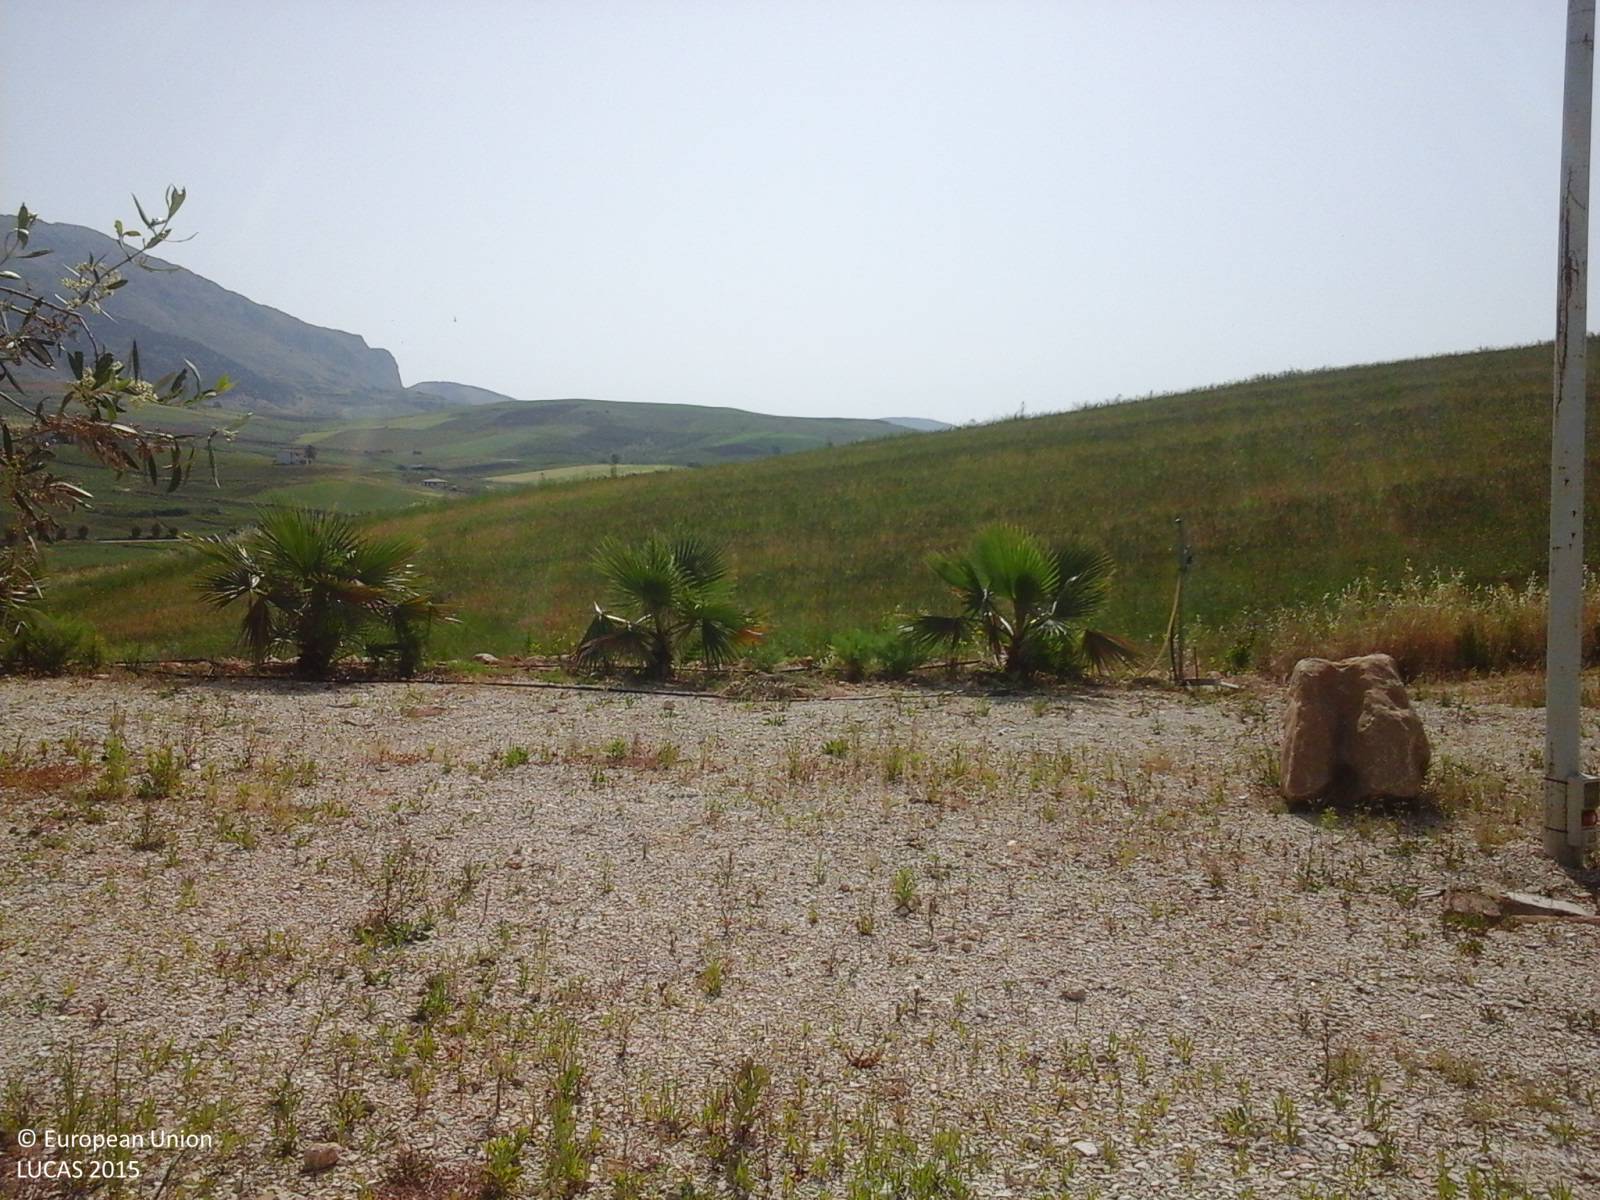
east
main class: Cropland
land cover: Olive groves
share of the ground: 25 - 50 %
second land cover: Spontaneously vegetated surfaces
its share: > 75 %
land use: Kitchen garden
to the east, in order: Olive groves; Spontaneously vegetated surfaces; Paved roads, cycling and walking lanes; Durum wheat; Paved roads, cycling and walking lanes; Grassland without tree/shrub cover; Tomatoes; Other fresh vegetables; Vineyards
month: May
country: IT
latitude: 37.9481
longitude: 13.1975
